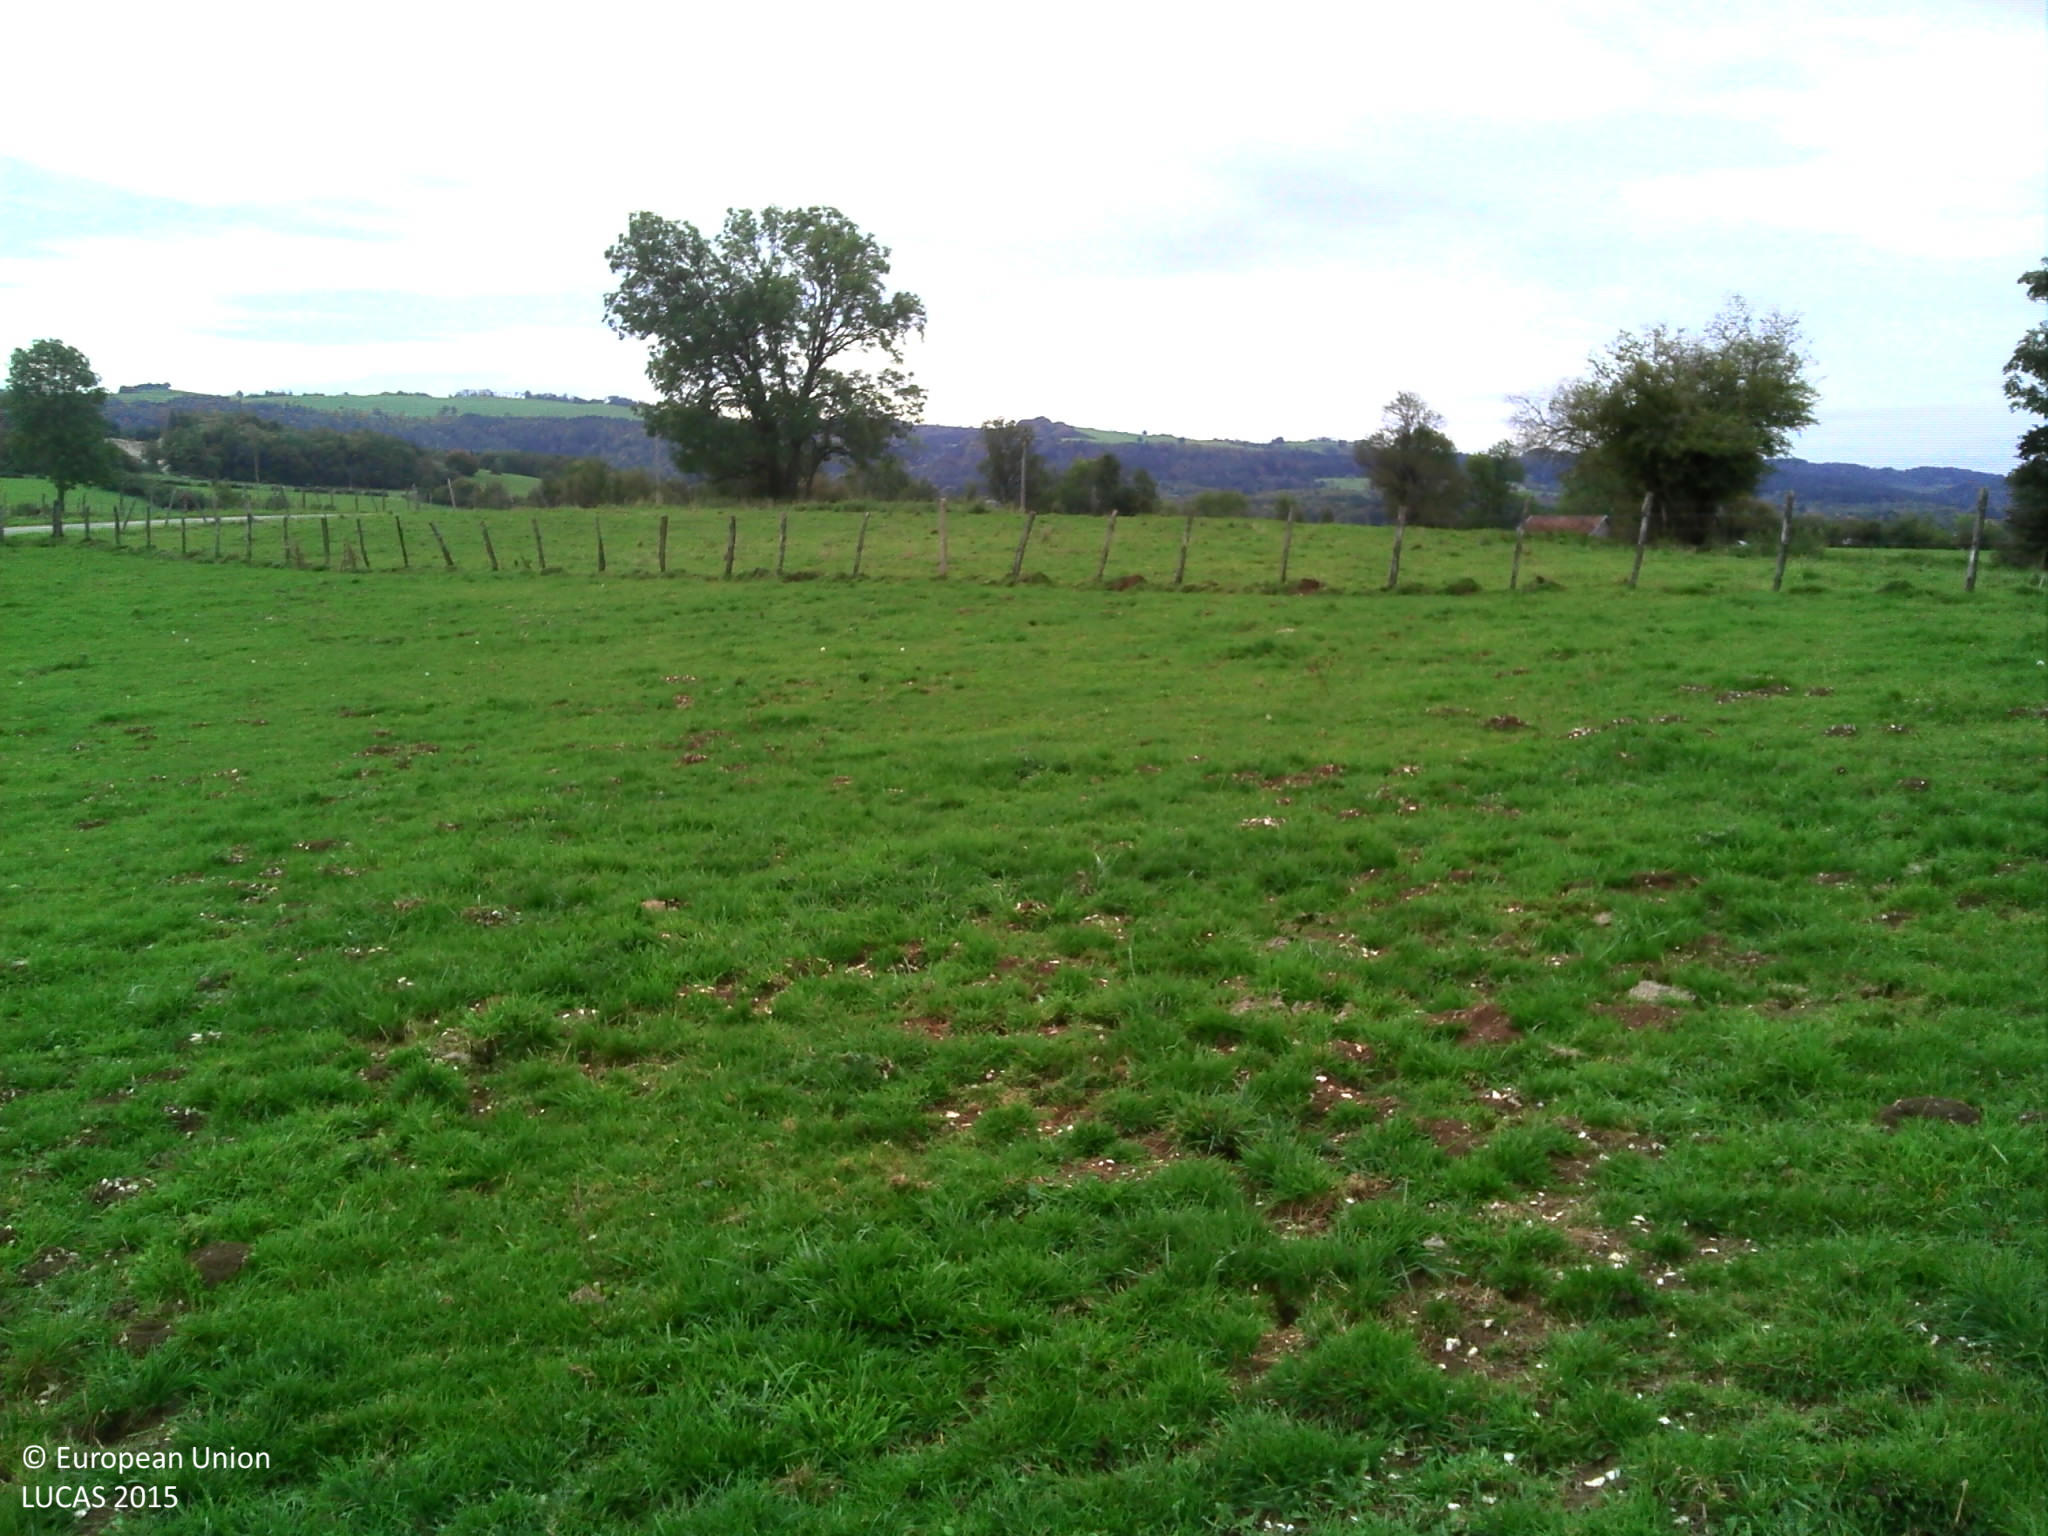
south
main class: Grassland
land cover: Grassland without tree/shrub cover
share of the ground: > 75 %
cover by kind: herbaceous plants 100 %
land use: Agriculture (excluding fallow land and kitchen gardens)
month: October
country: FR
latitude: 47.0390
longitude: 6.1460
